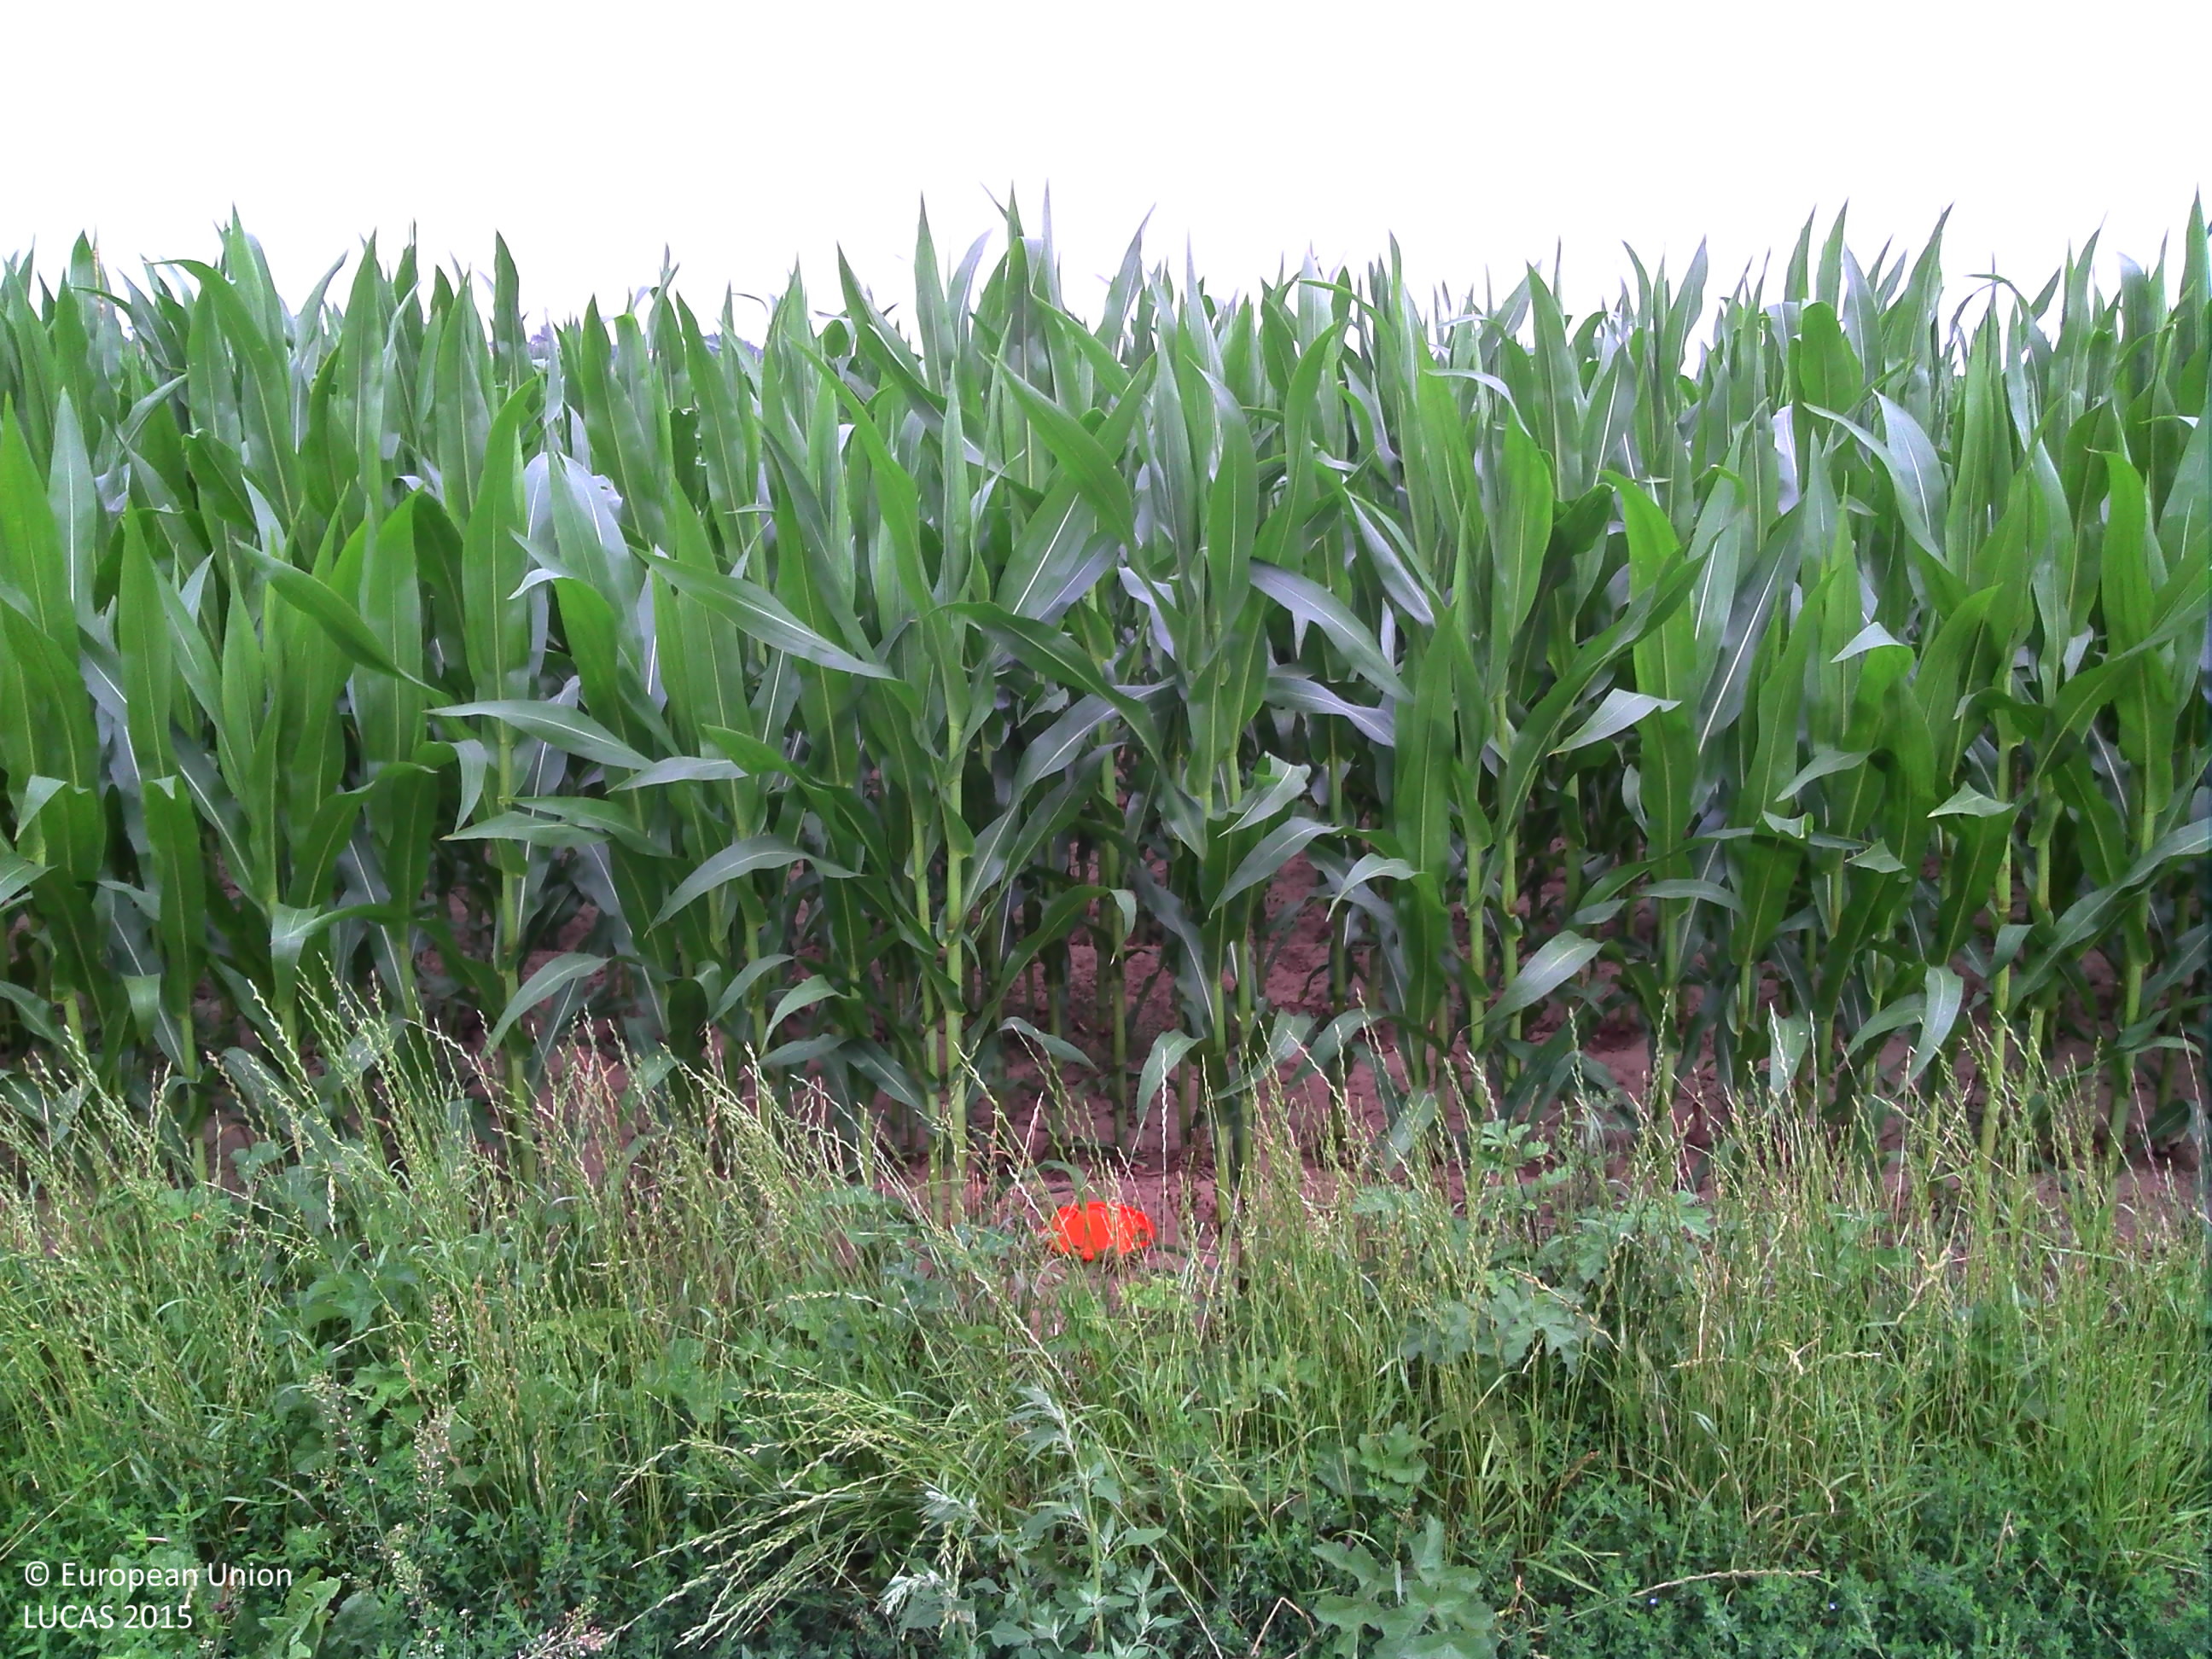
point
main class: Cropland
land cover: Maize
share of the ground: > 75 %
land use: Agriculture (excluding fallow land and kitchen gardens)
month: July
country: BE
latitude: 50.8022
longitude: 5.6139
